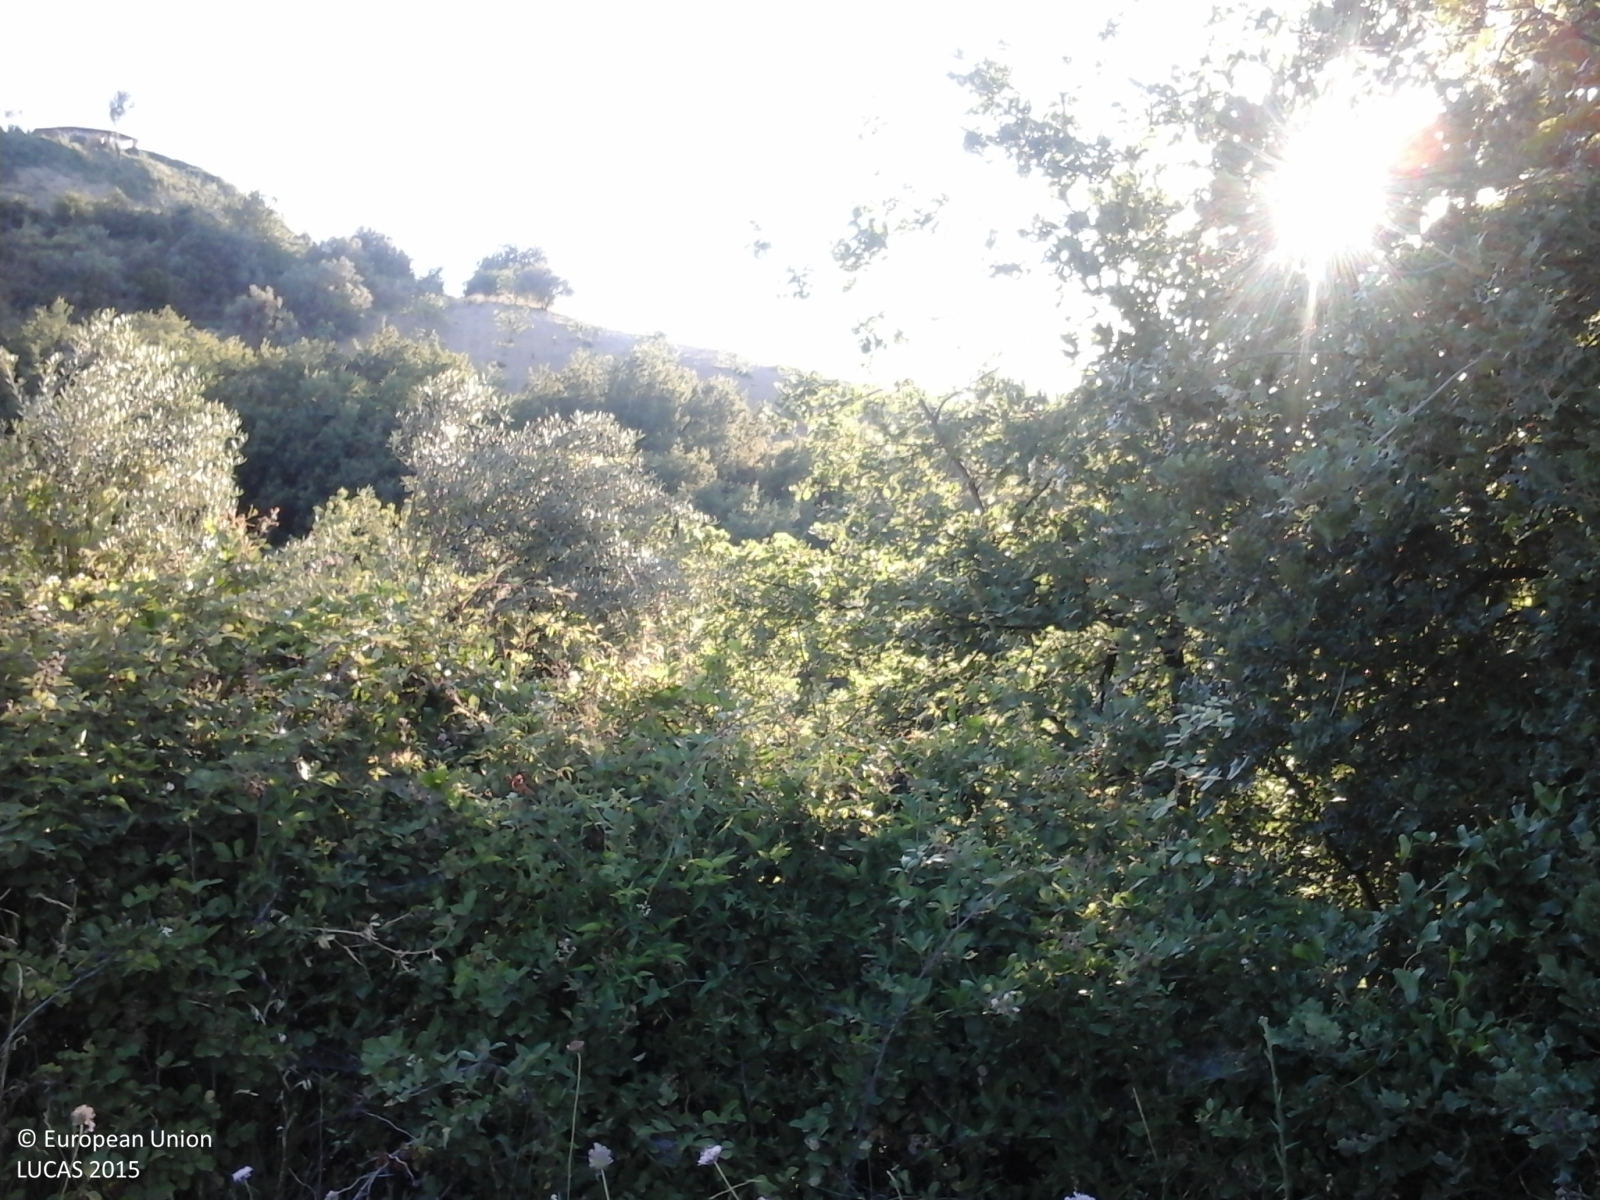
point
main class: Woodland
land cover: Broadleaved woodland
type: thermophilous deciduous forest
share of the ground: > 75 %
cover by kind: broadleaved forest trees 100 %
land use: Forestry
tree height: > 5 m
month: June
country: IT
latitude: 40.3739
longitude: 15.0307
